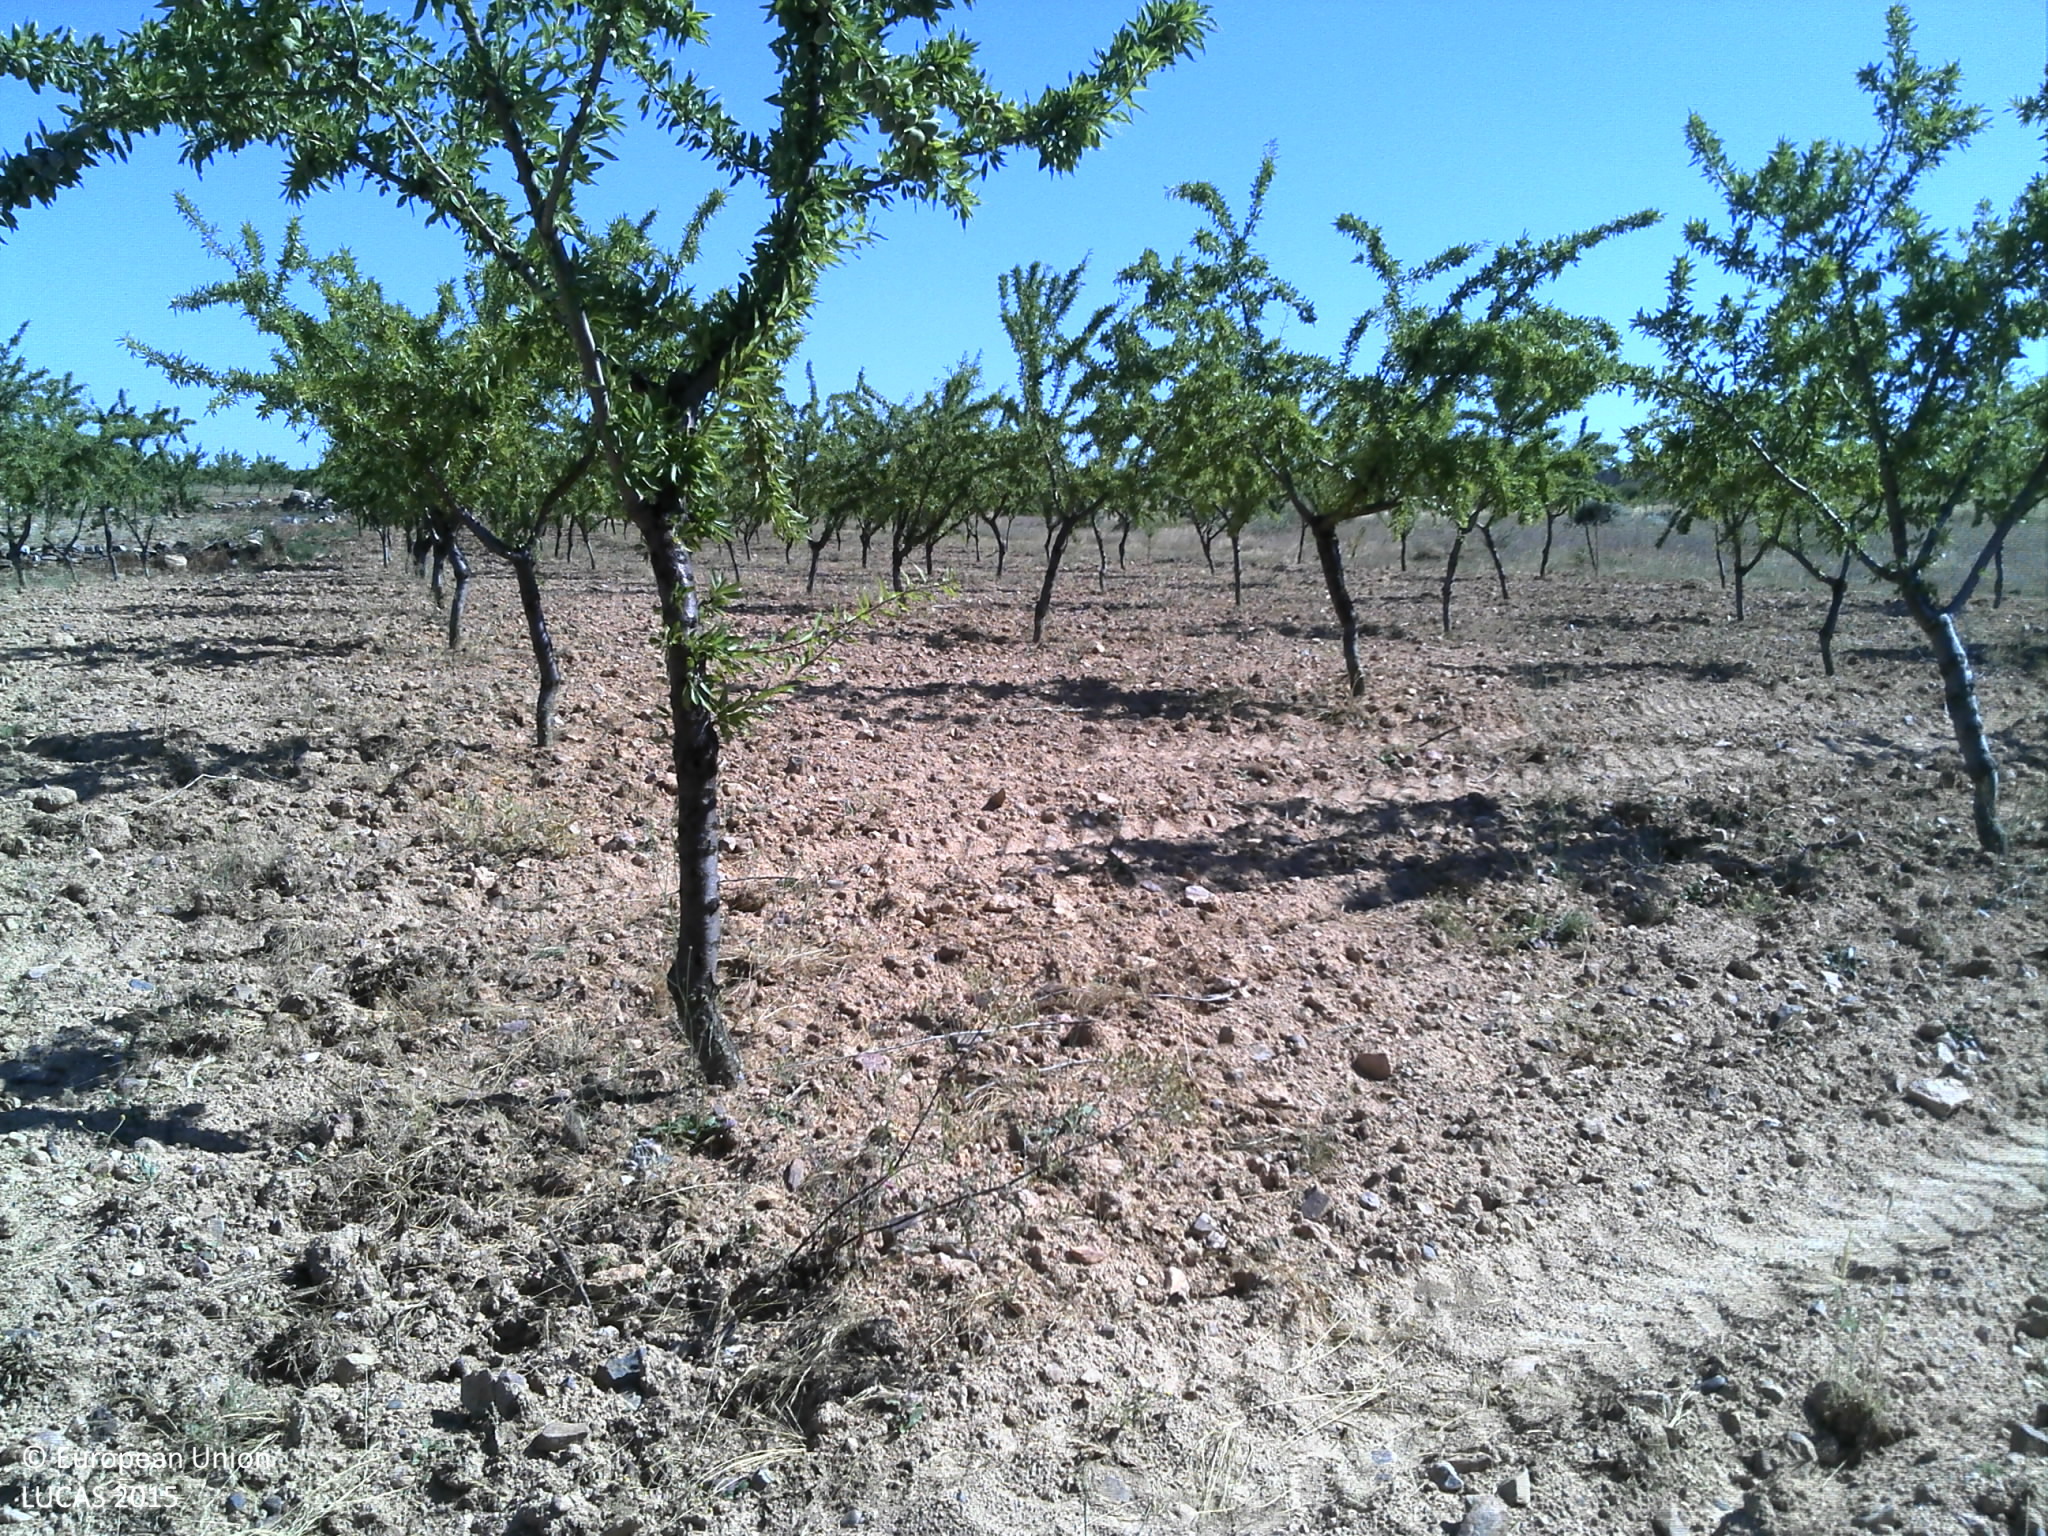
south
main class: Cropland
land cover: Nuts trees
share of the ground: < 10 %
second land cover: Other bare soil
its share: > 75 %
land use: Agriculture (excluding fallow land and kitchen gardens)
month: June
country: PT
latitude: 41.1921
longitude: -6.8585
